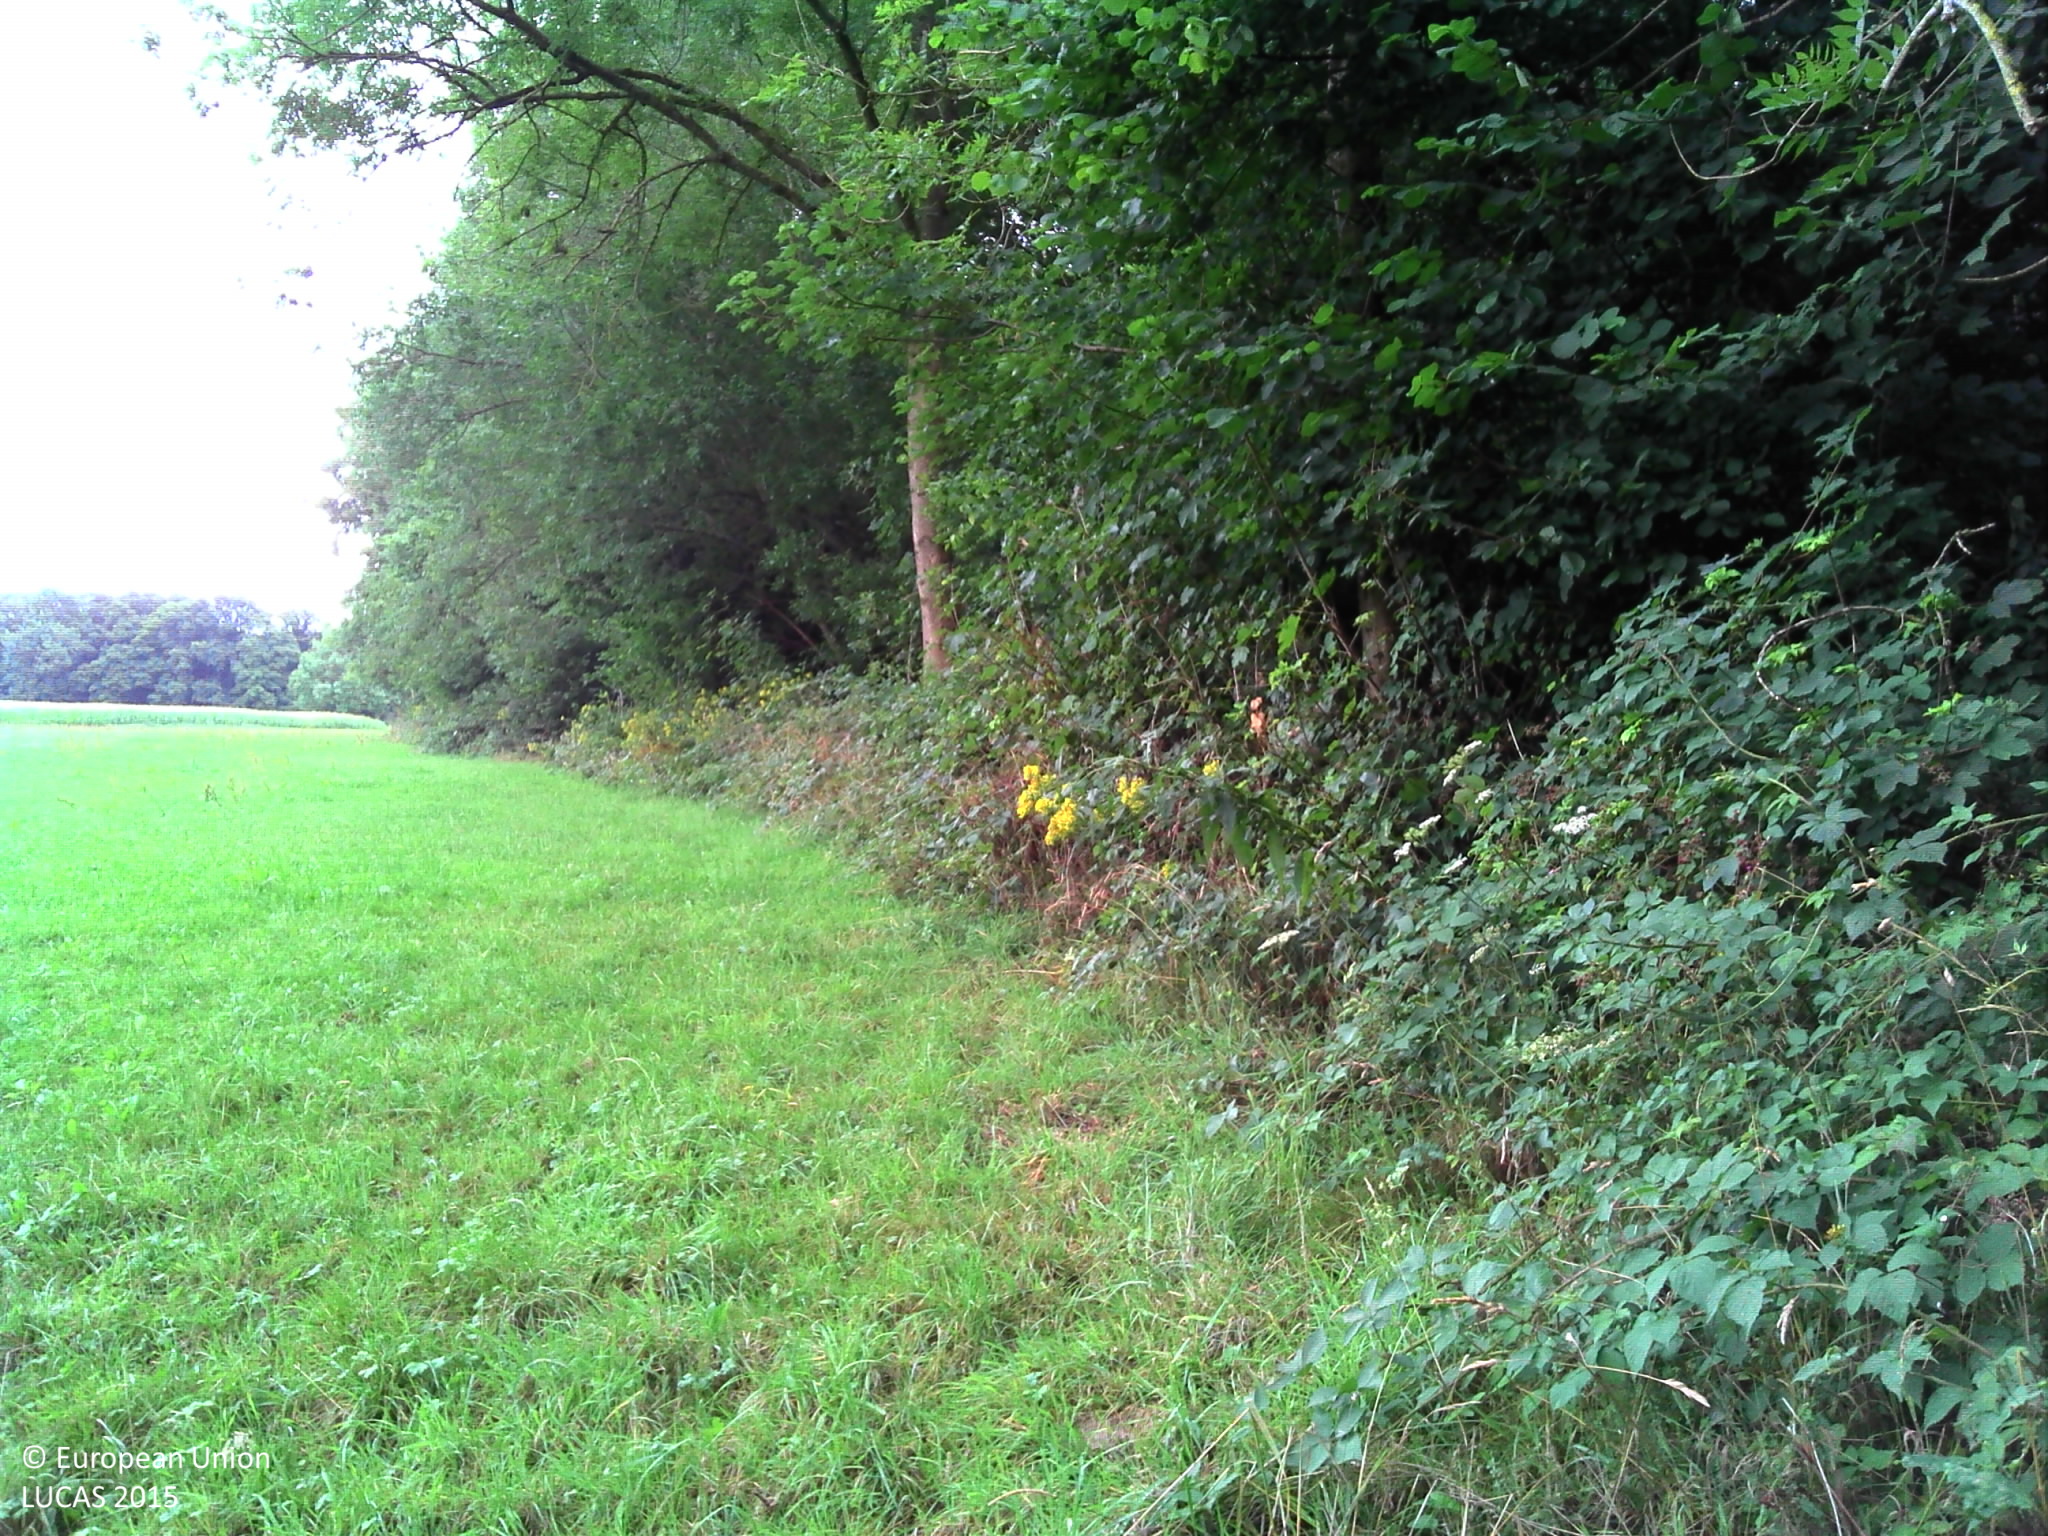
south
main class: Woodland
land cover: Broadleaved woodland
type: mesophytic deciduous forest
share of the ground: > 75 %
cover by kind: broadleaved forest trees 85 %, lichens and mosses 10 %, herbaceous plants 5 %
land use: Forestry
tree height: > 5 m
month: August
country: FR
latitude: 50.2115
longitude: 4.0952
